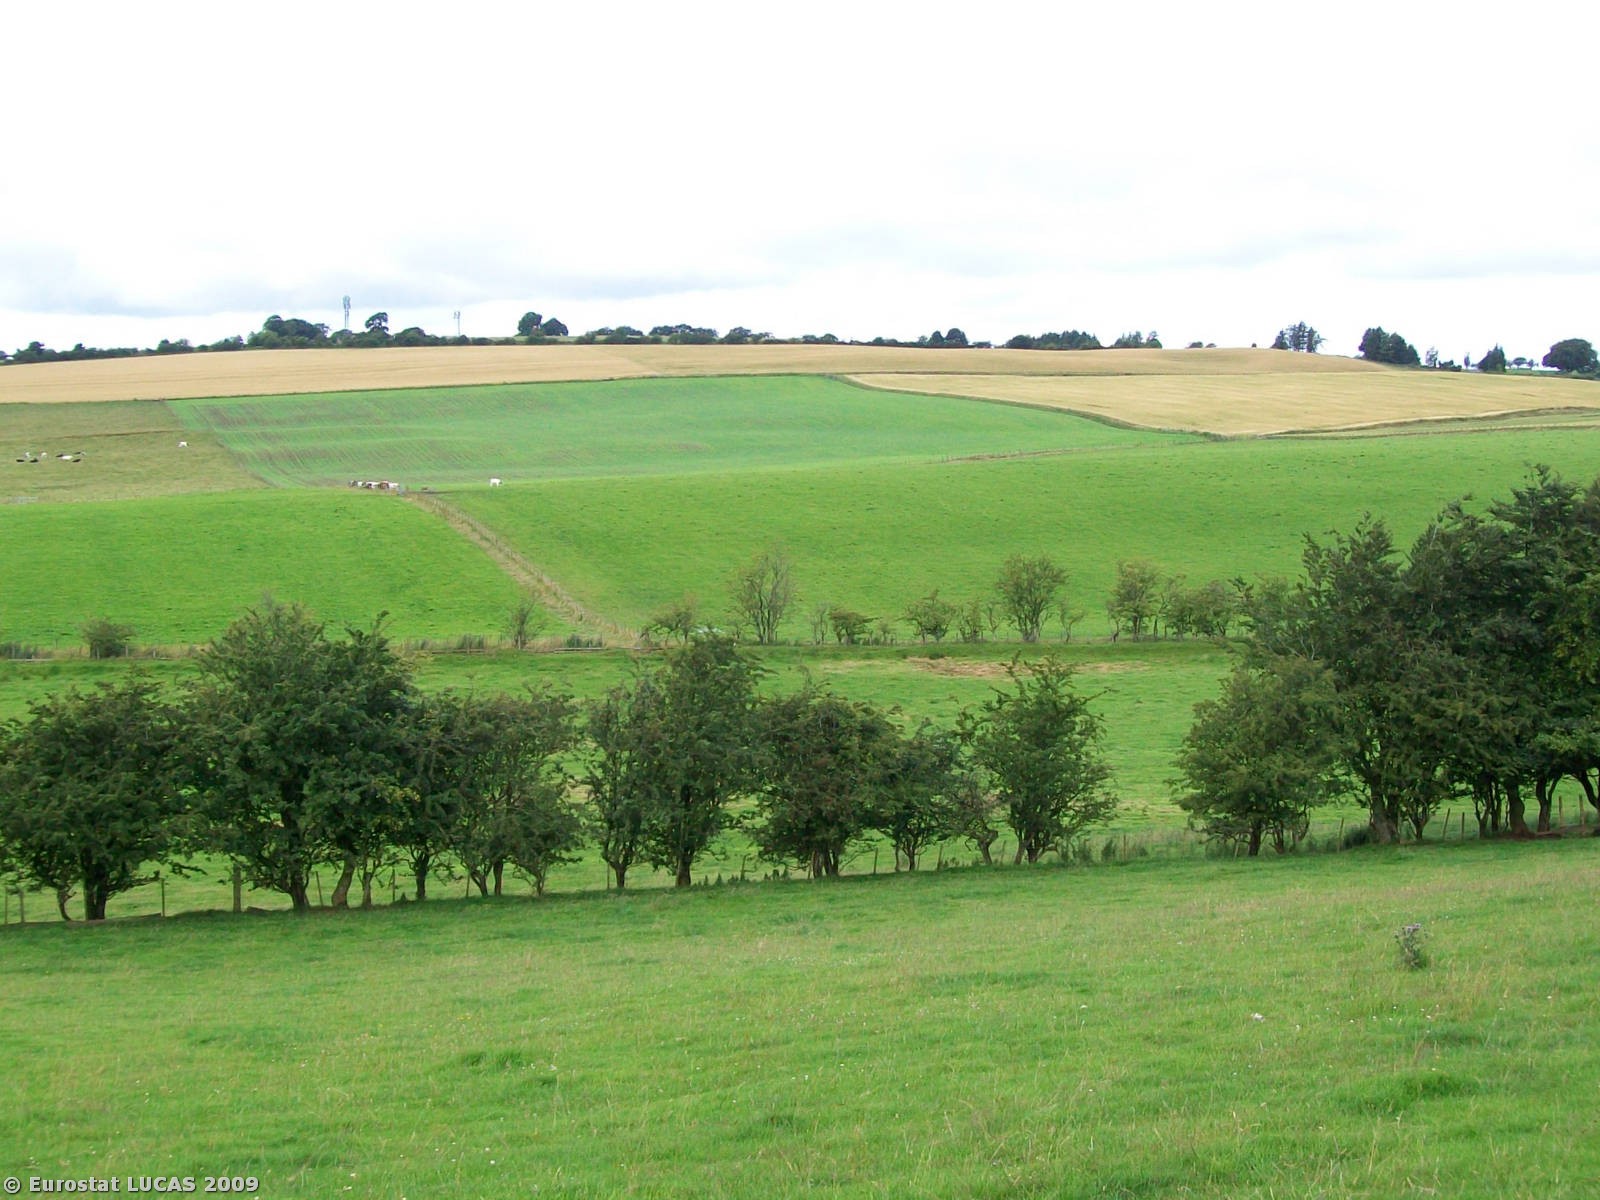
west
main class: Grassland
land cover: Grassland without tree/shrub cover
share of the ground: > 75 %
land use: Agriculture (excluding fallow land and kitchen gardens)
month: July
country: GB
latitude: 55.1553
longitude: -3.3702
